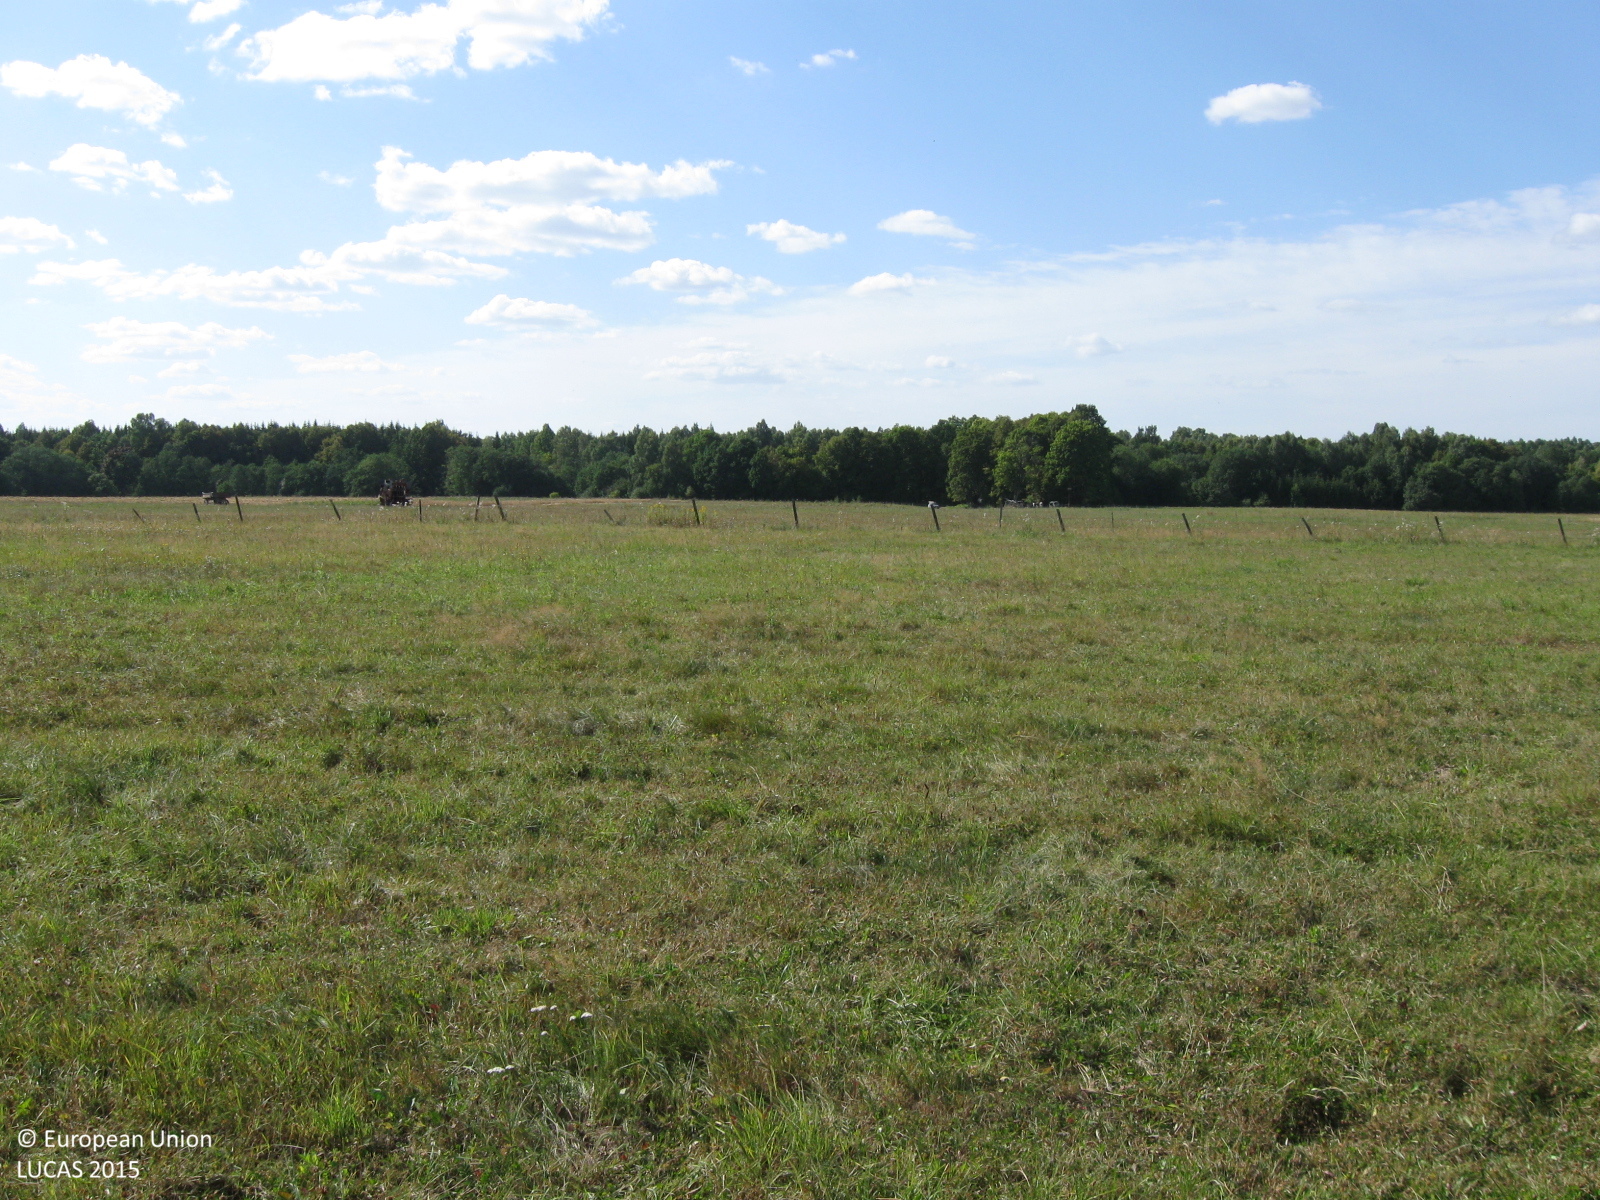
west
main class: Grassland
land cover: Grassland without tree/shrub cover
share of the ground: > 75 %
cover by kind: herbaceous plants 100 %
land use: Agriculture (excluding fallow land and kitchen gardens)
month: August
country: LT
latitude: 55.2276
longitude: 22.4981
